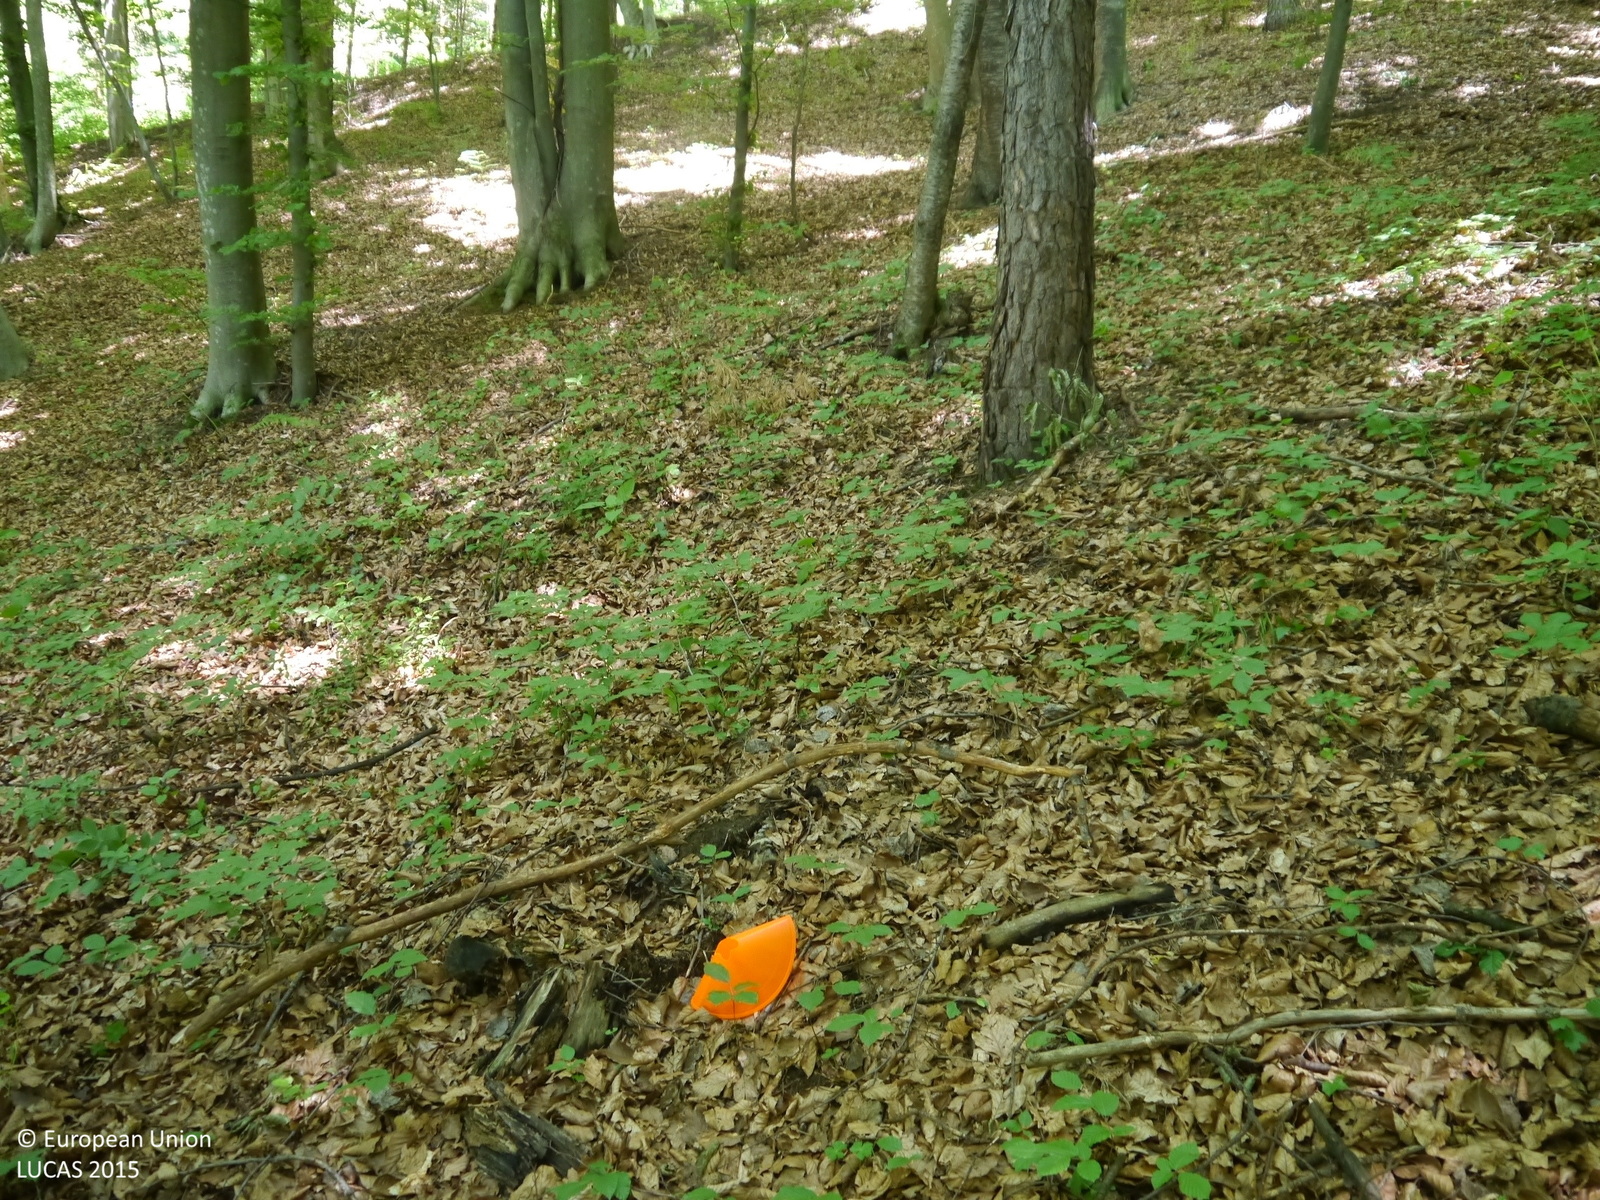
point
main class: Woodland
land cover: Broadleaved woodland
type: mountainous beech forest
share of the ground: > 75 %
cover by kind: broadleaved forest trees 95 %, coniferous forest trees 5 %
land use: Forestry
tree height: > 5 m
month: June
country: AT
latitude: 46.9427
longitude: 15.6358
